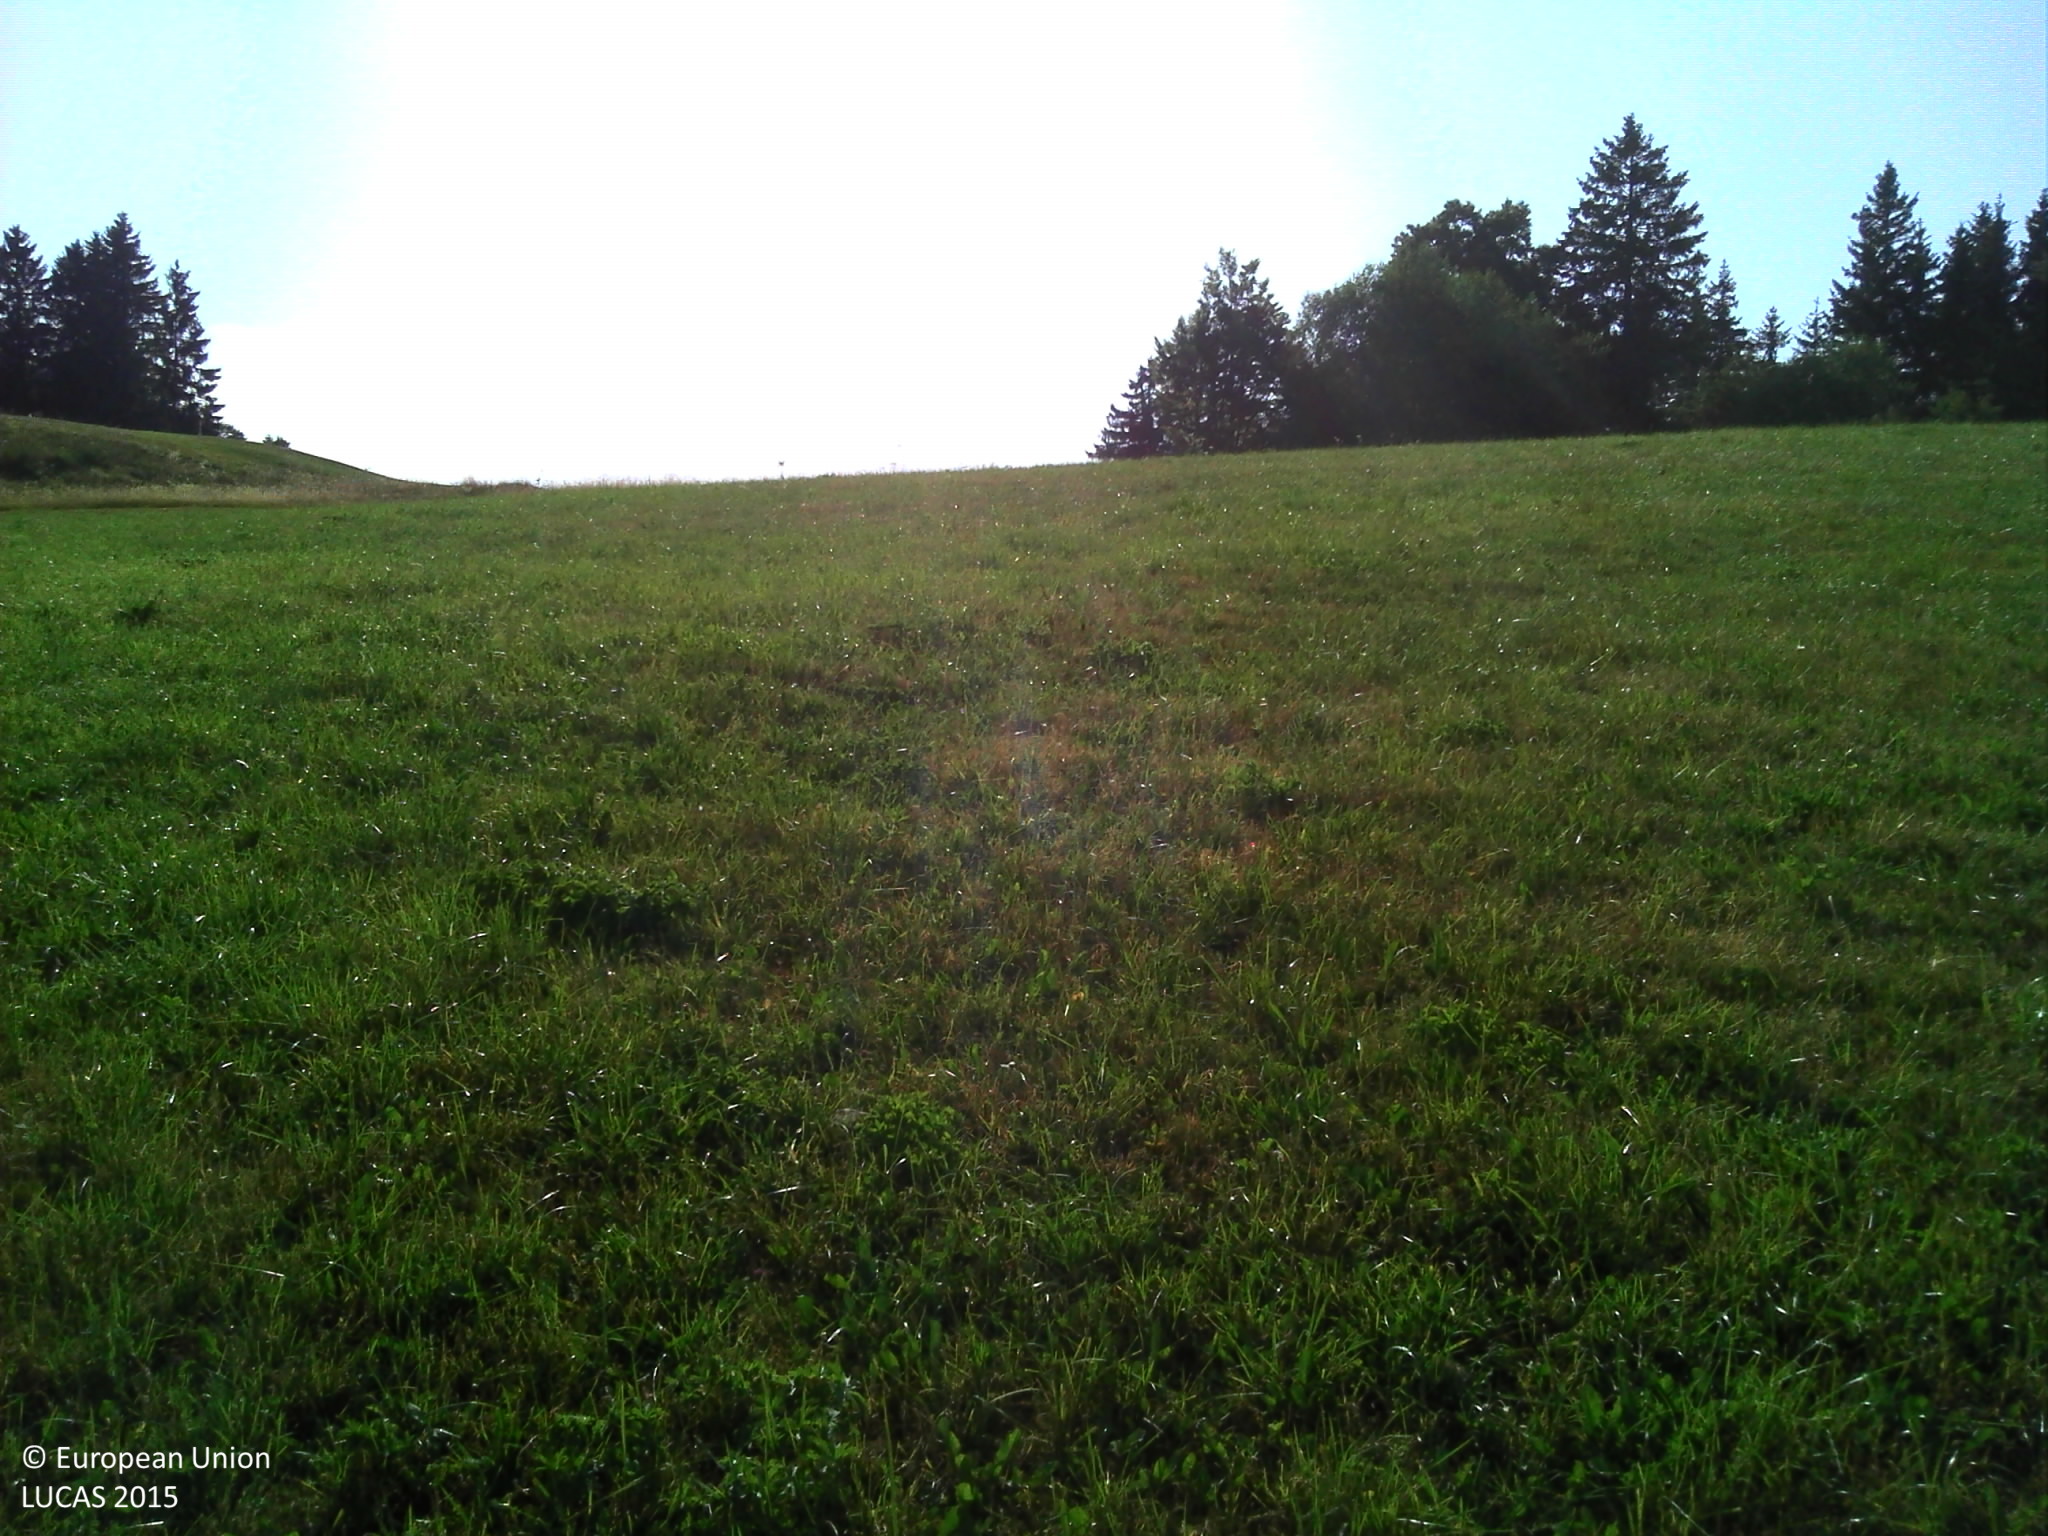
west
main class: Grassland
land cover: Grassland without tree/shrub cover
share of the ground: > 75 %
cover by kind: herbaceous plants 100 %
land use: Agriculture (excluding fallow land and kitchen gardens)
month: July
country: FR
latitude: 46.4778
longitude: 6.0825
